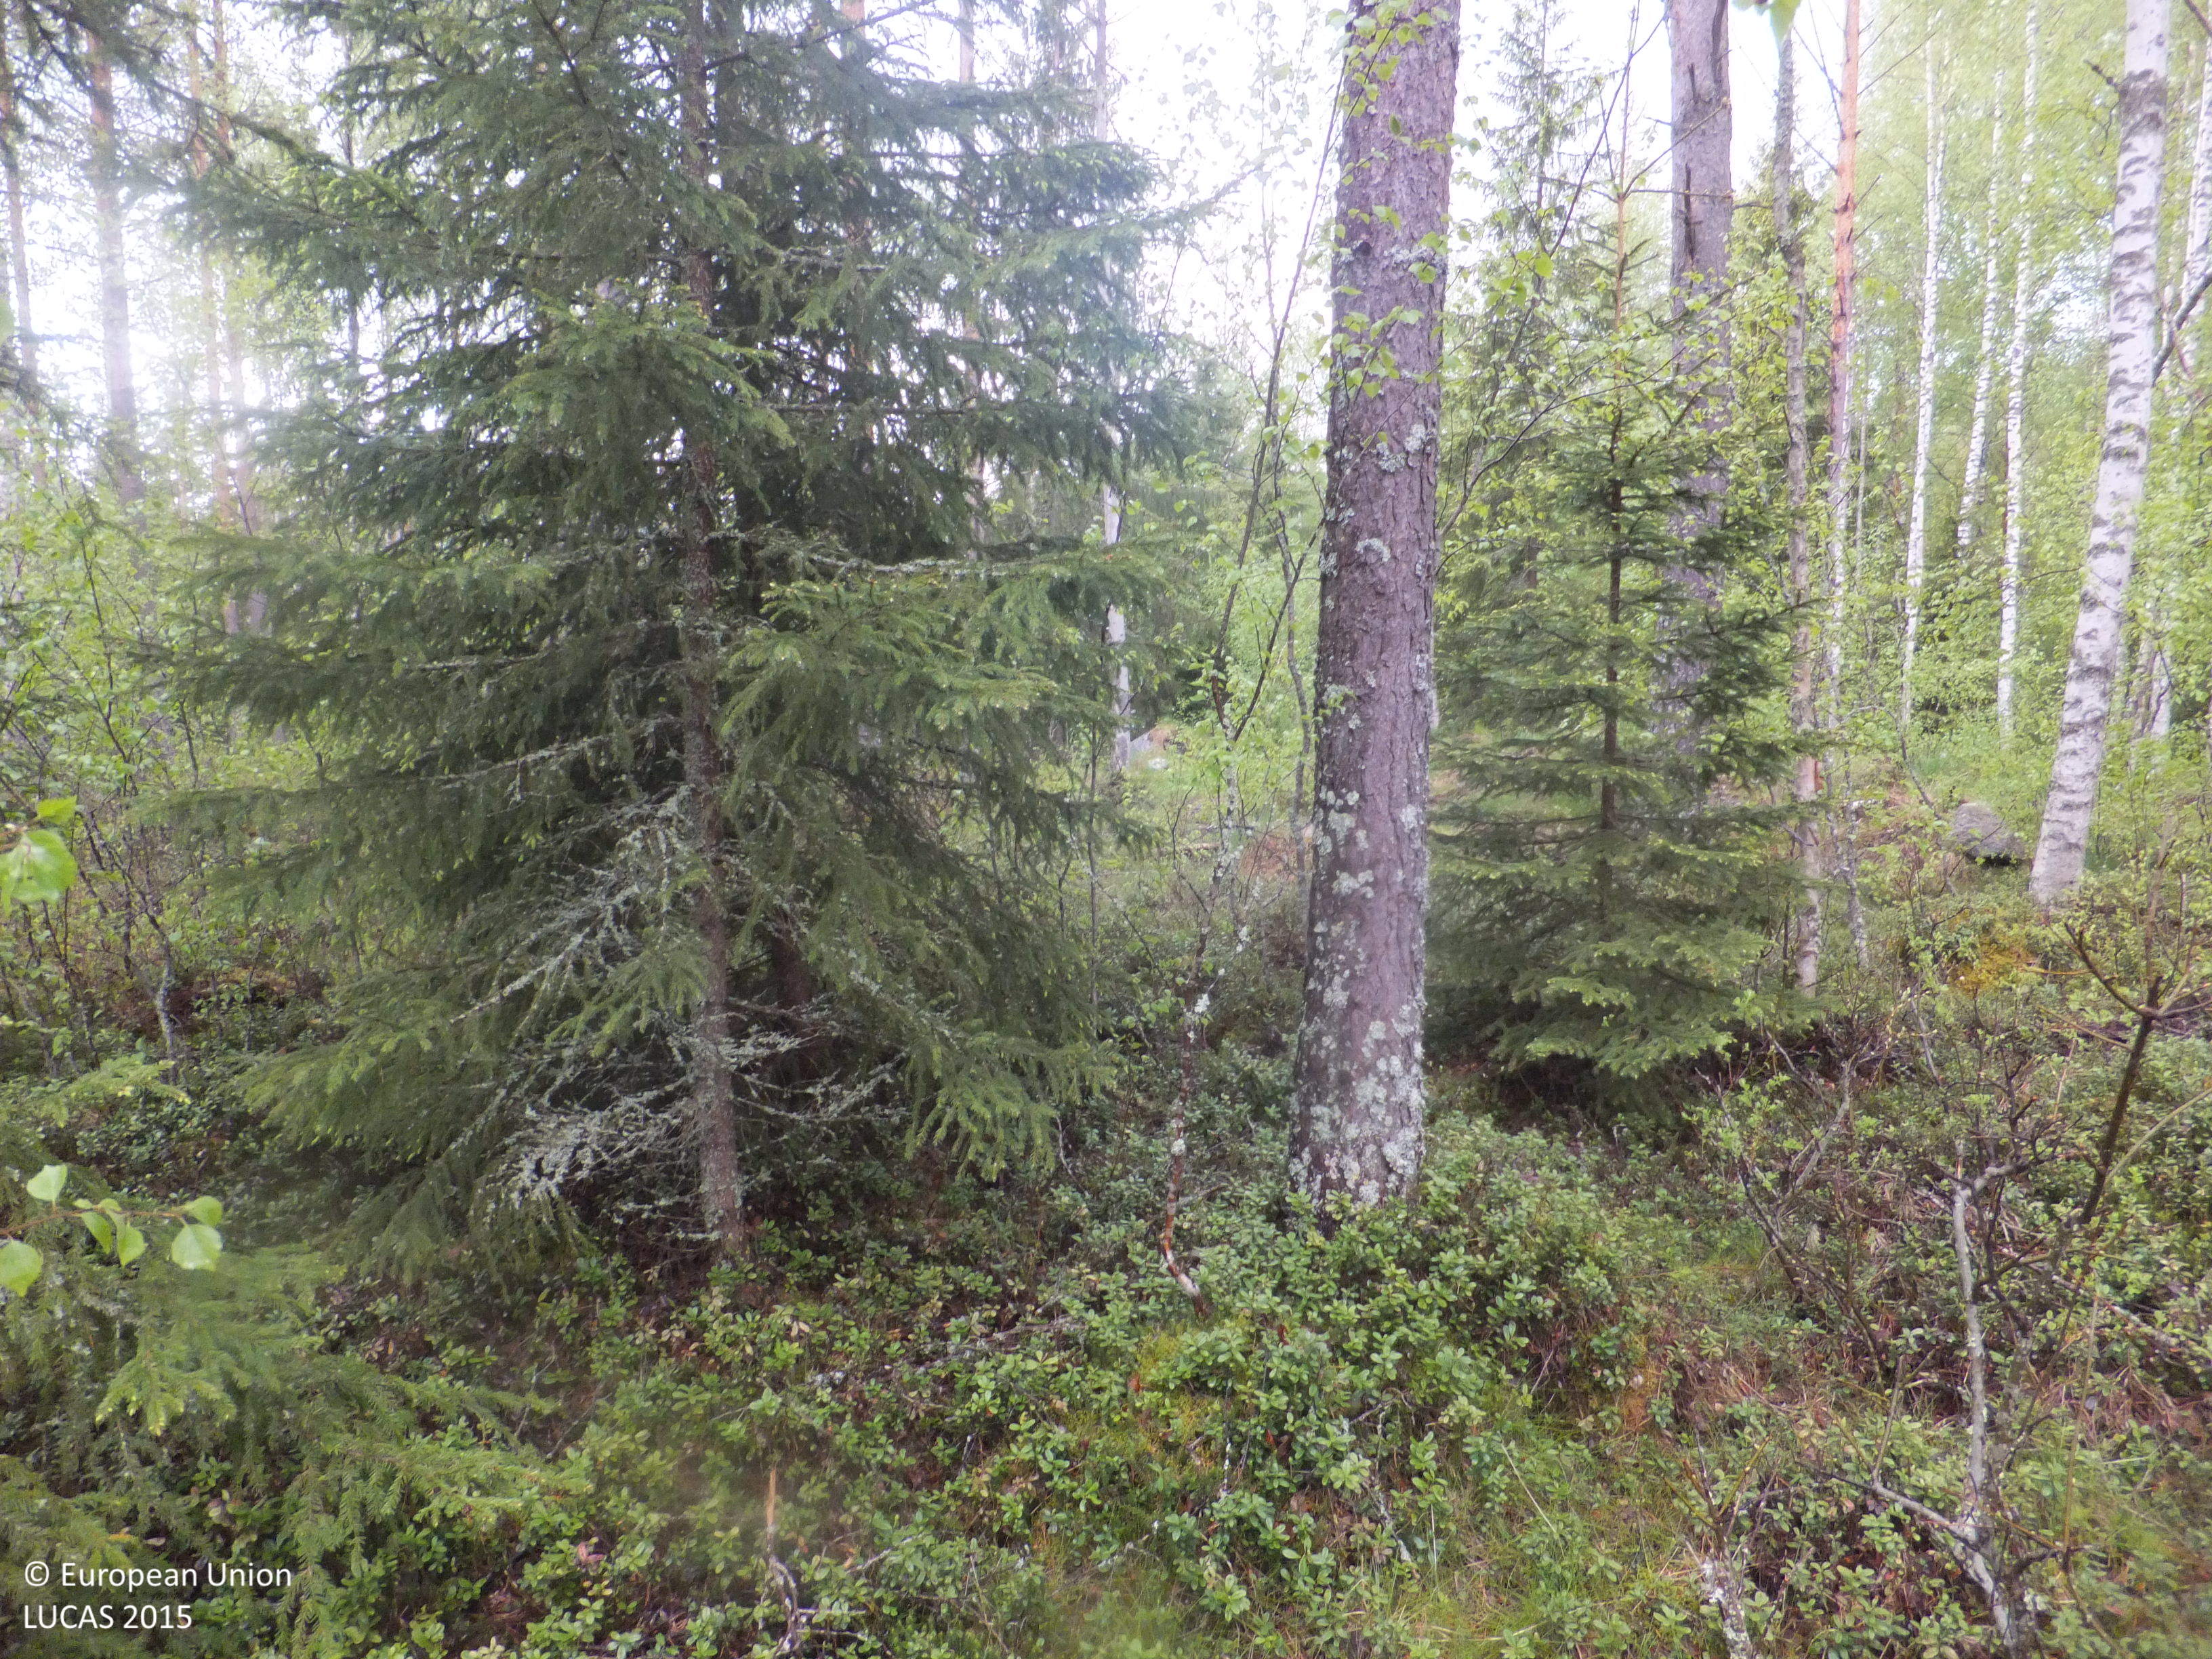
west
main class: Woodland
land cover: Pine dominated mixed woodland
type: boreal forest
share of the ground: > 75 %
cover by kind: coniferous forest trees 60 %, broadleaved forest trees 30 %, shrubs 5 %, lichens and mosses 5 %
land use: Forestry
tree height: > 5 m
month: June
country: FI
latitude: 63.3881
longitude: 23.1640
